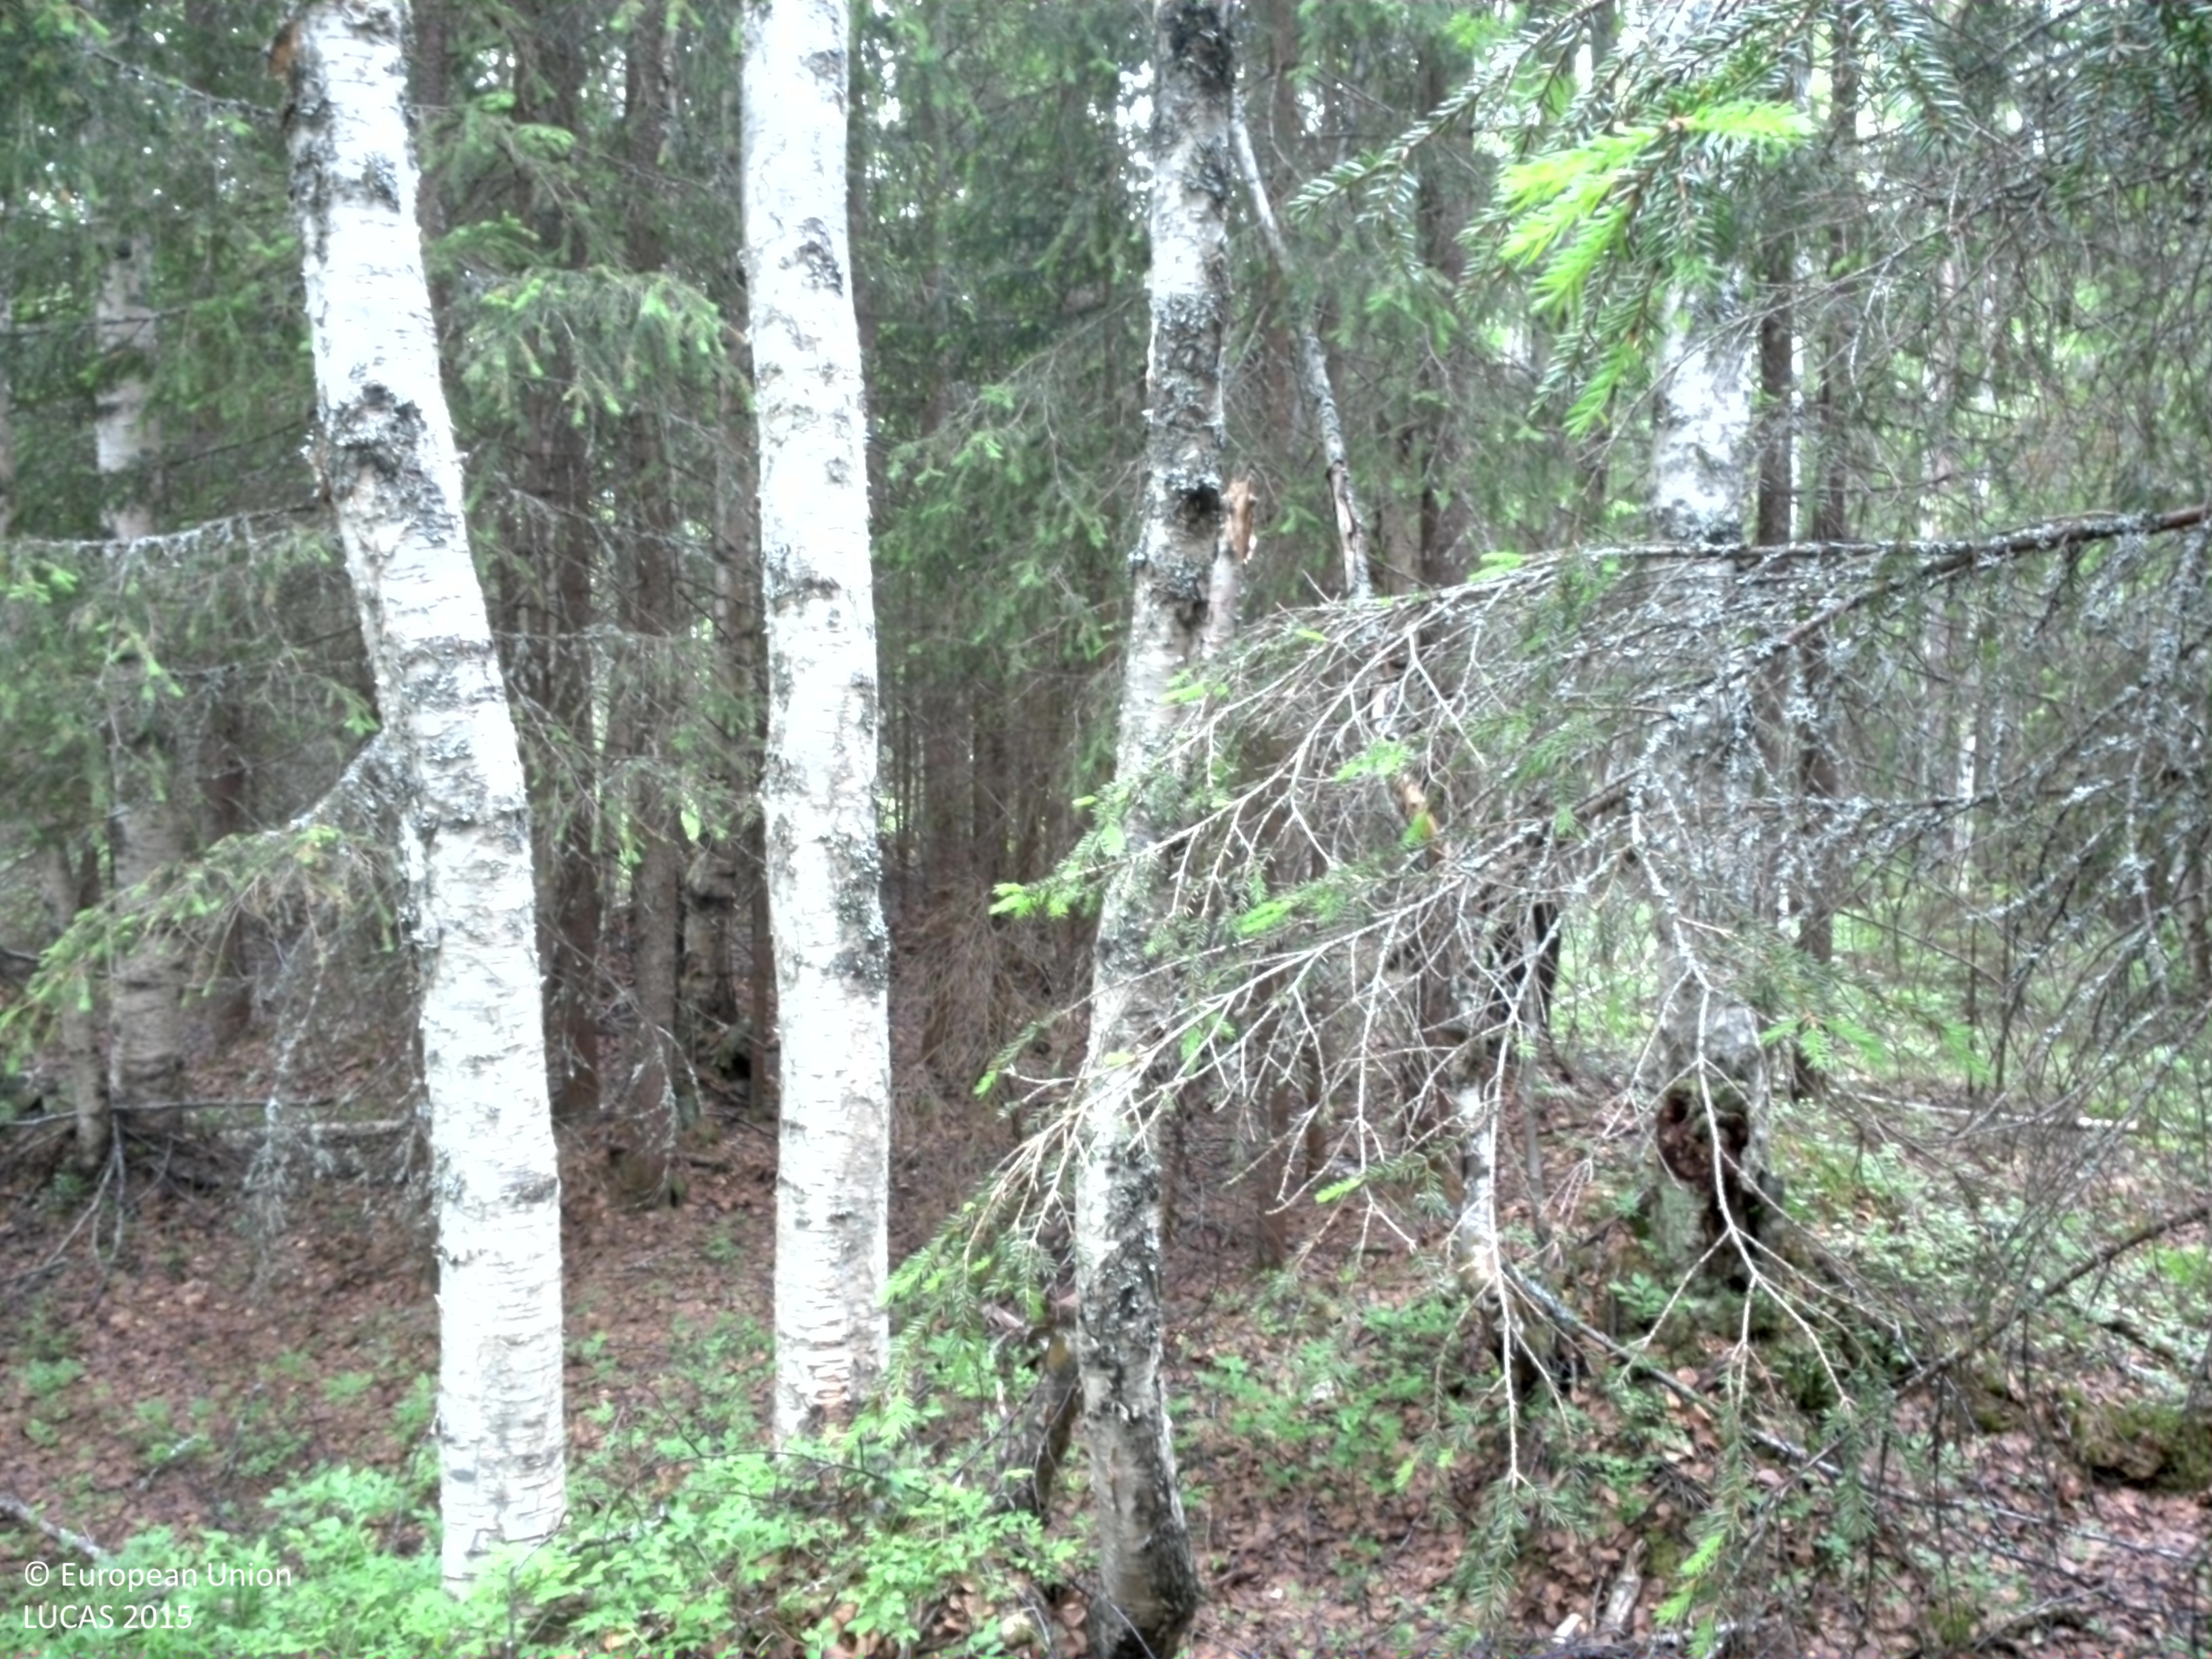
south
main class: Woodland
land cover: Other mixed woodland
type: boreal forest
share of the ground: > 75 %
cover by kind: coniferous forest trees 55 %, broadleaved forest trees 30 %, shrubs 15 %
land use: Forestry
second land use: Amenities, museums, leisure
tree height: > 5 m
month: July
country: SE
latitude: 64.4361
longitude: 20.7174
